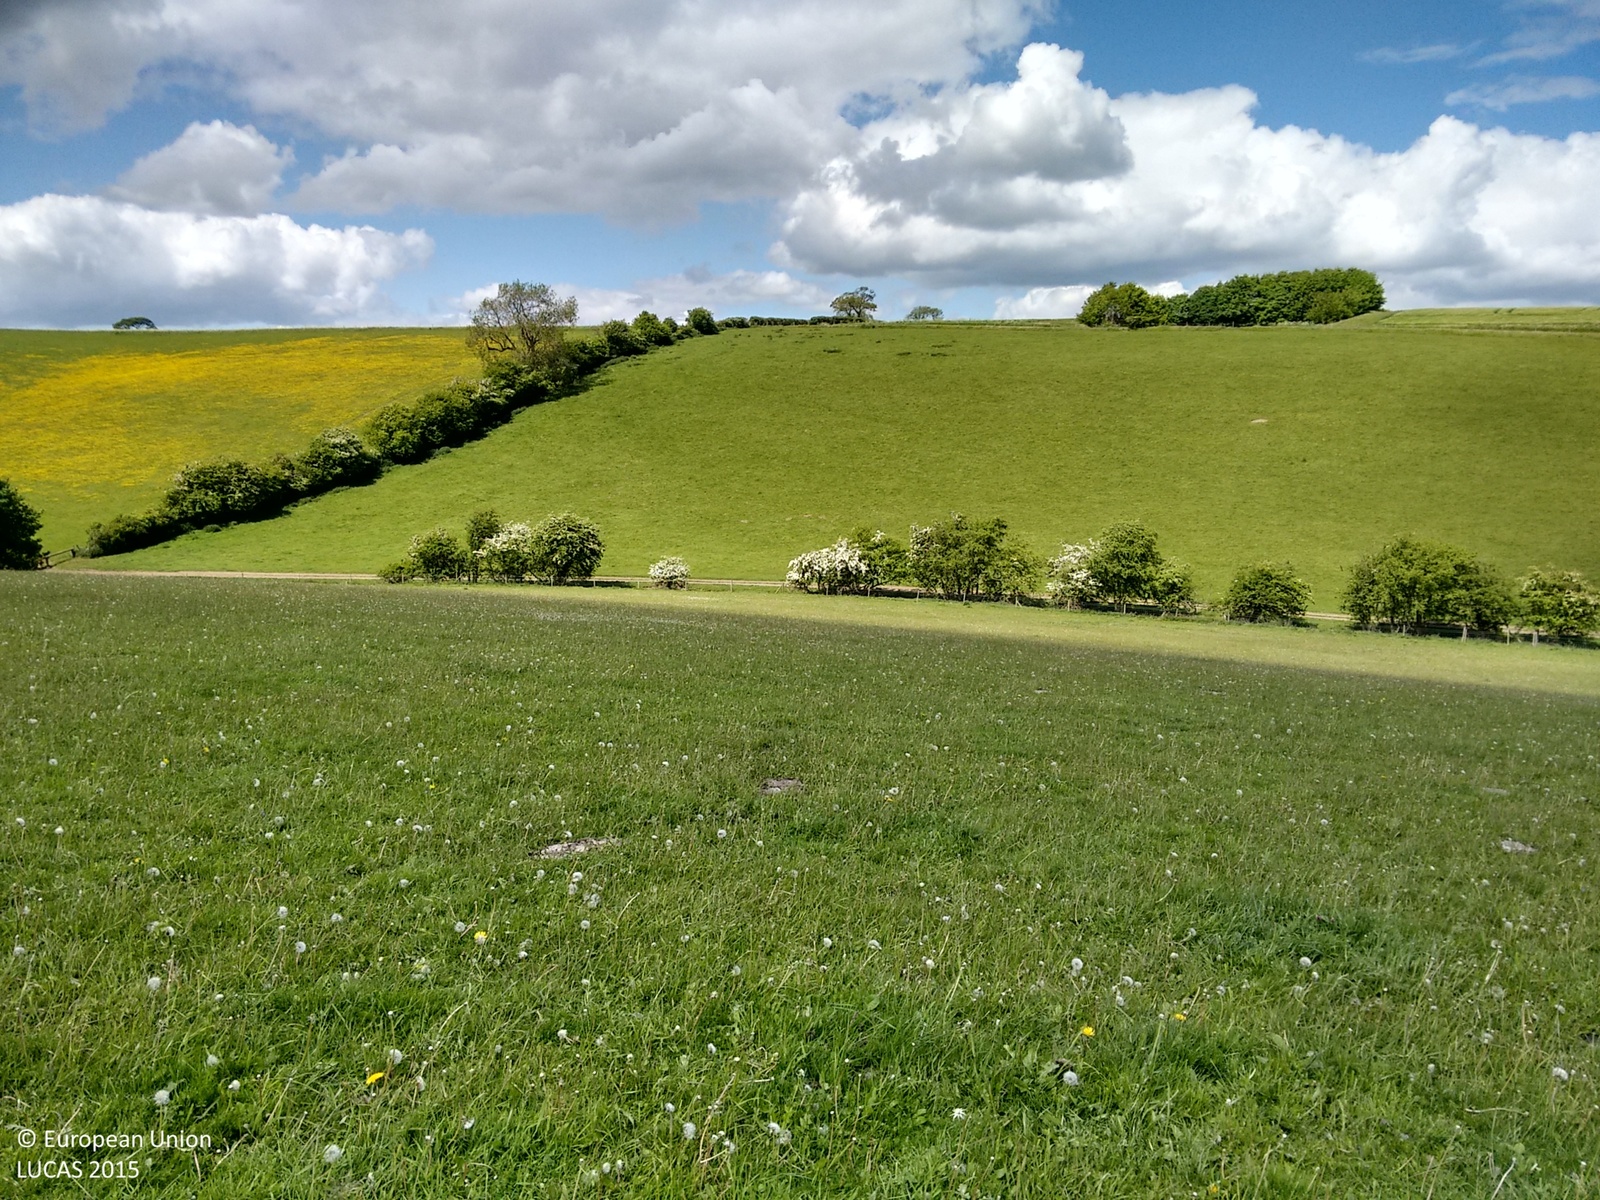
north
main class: Grassland
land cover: Grassland without tree/shrub cover
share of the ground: > 75 %
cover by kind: herbaceous plants 100 %
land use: Agriculture (excluding fallow land and kitchen gardens)
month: May
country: GB
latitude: 53.4367
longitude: -0.2555
